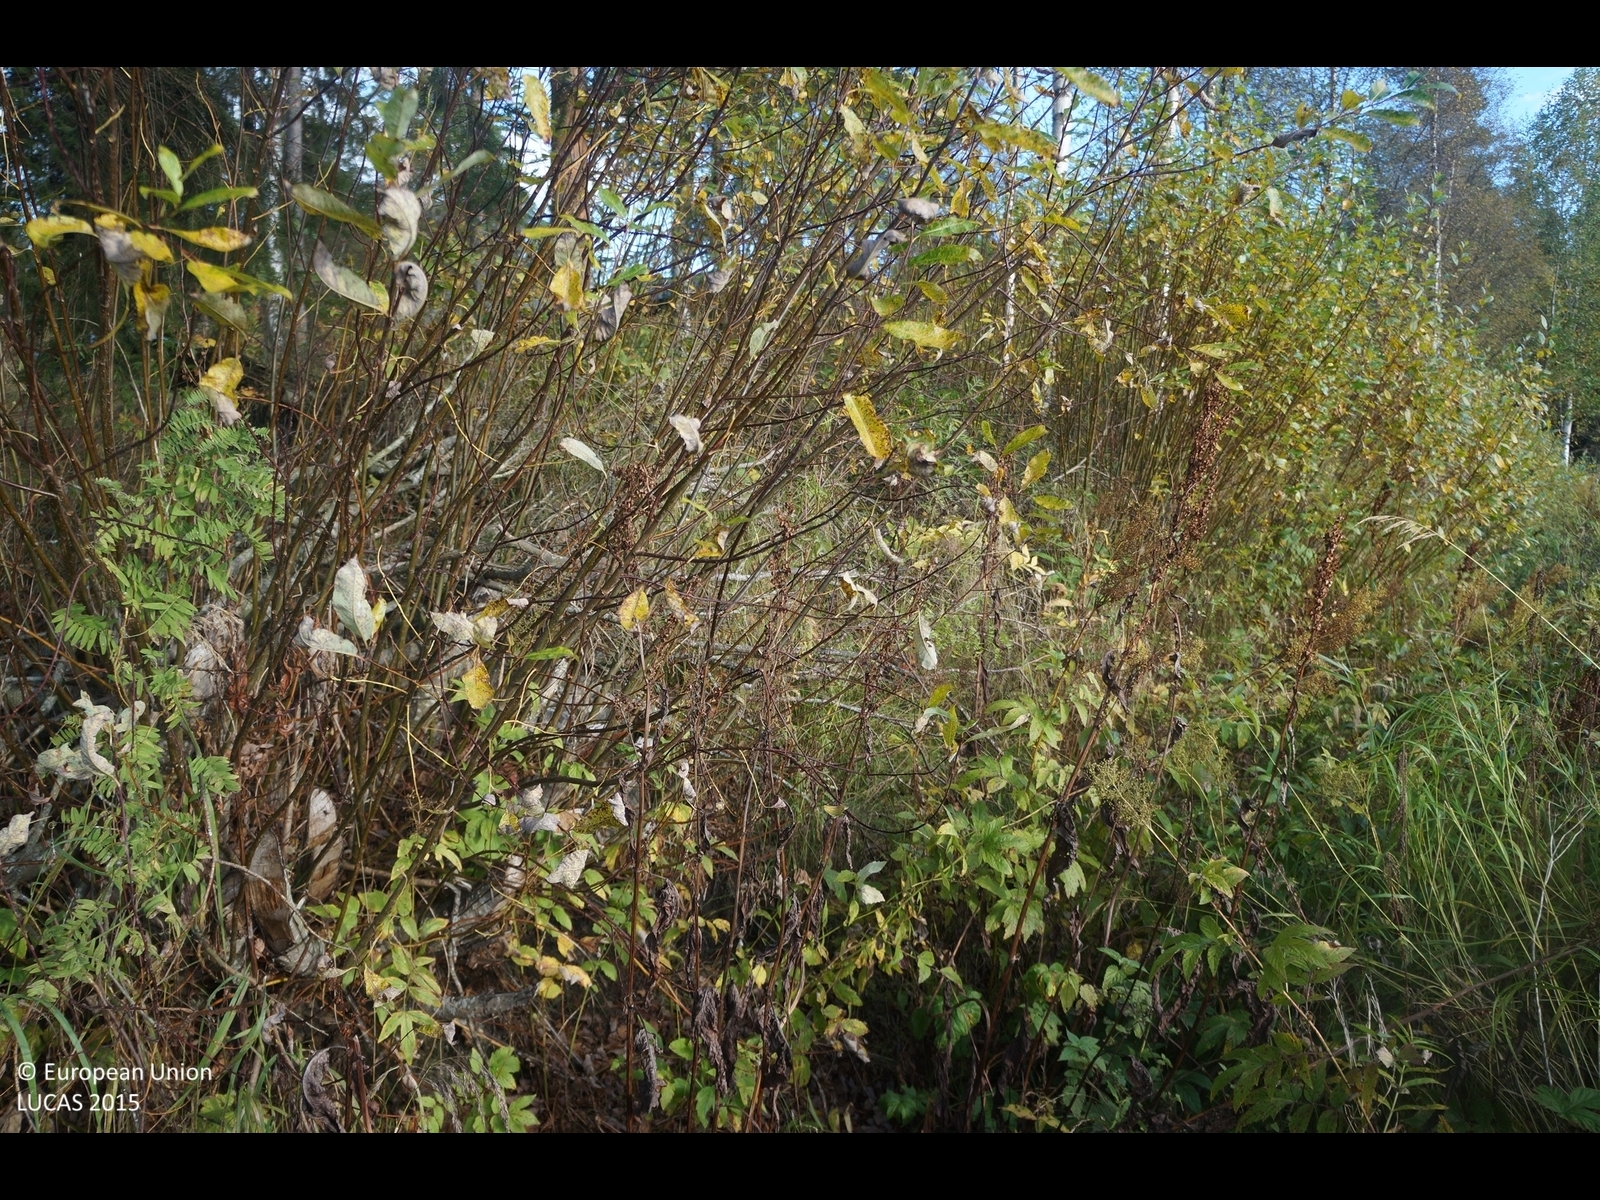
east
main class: Woodland
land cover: Spruce dominated mixed woodland
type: boreal forest
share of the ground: 50 - 75 %
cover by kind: coniferous forest trees 50 %, broadleaved forest trees 20 %, shrubs 20 %, lichens and mosses 10 %
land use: Forestry
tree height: > 5 m
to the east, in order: Spruce dominated mixed woodland; Spontaneously vegetated surfaces; Spruce dominated mixed woodland; Artificial constructions in urban areas; Ditches and canals; Pine dominated coniferous woodland; Spruce dominated coniferous woodland; Spontaneously vegetated surfaces; Ditches and canals; Spruce dominated mixed woodland; Spruce dominated coniferous woodland
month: September
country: FI
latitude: 64.2721
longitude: 24.5881
